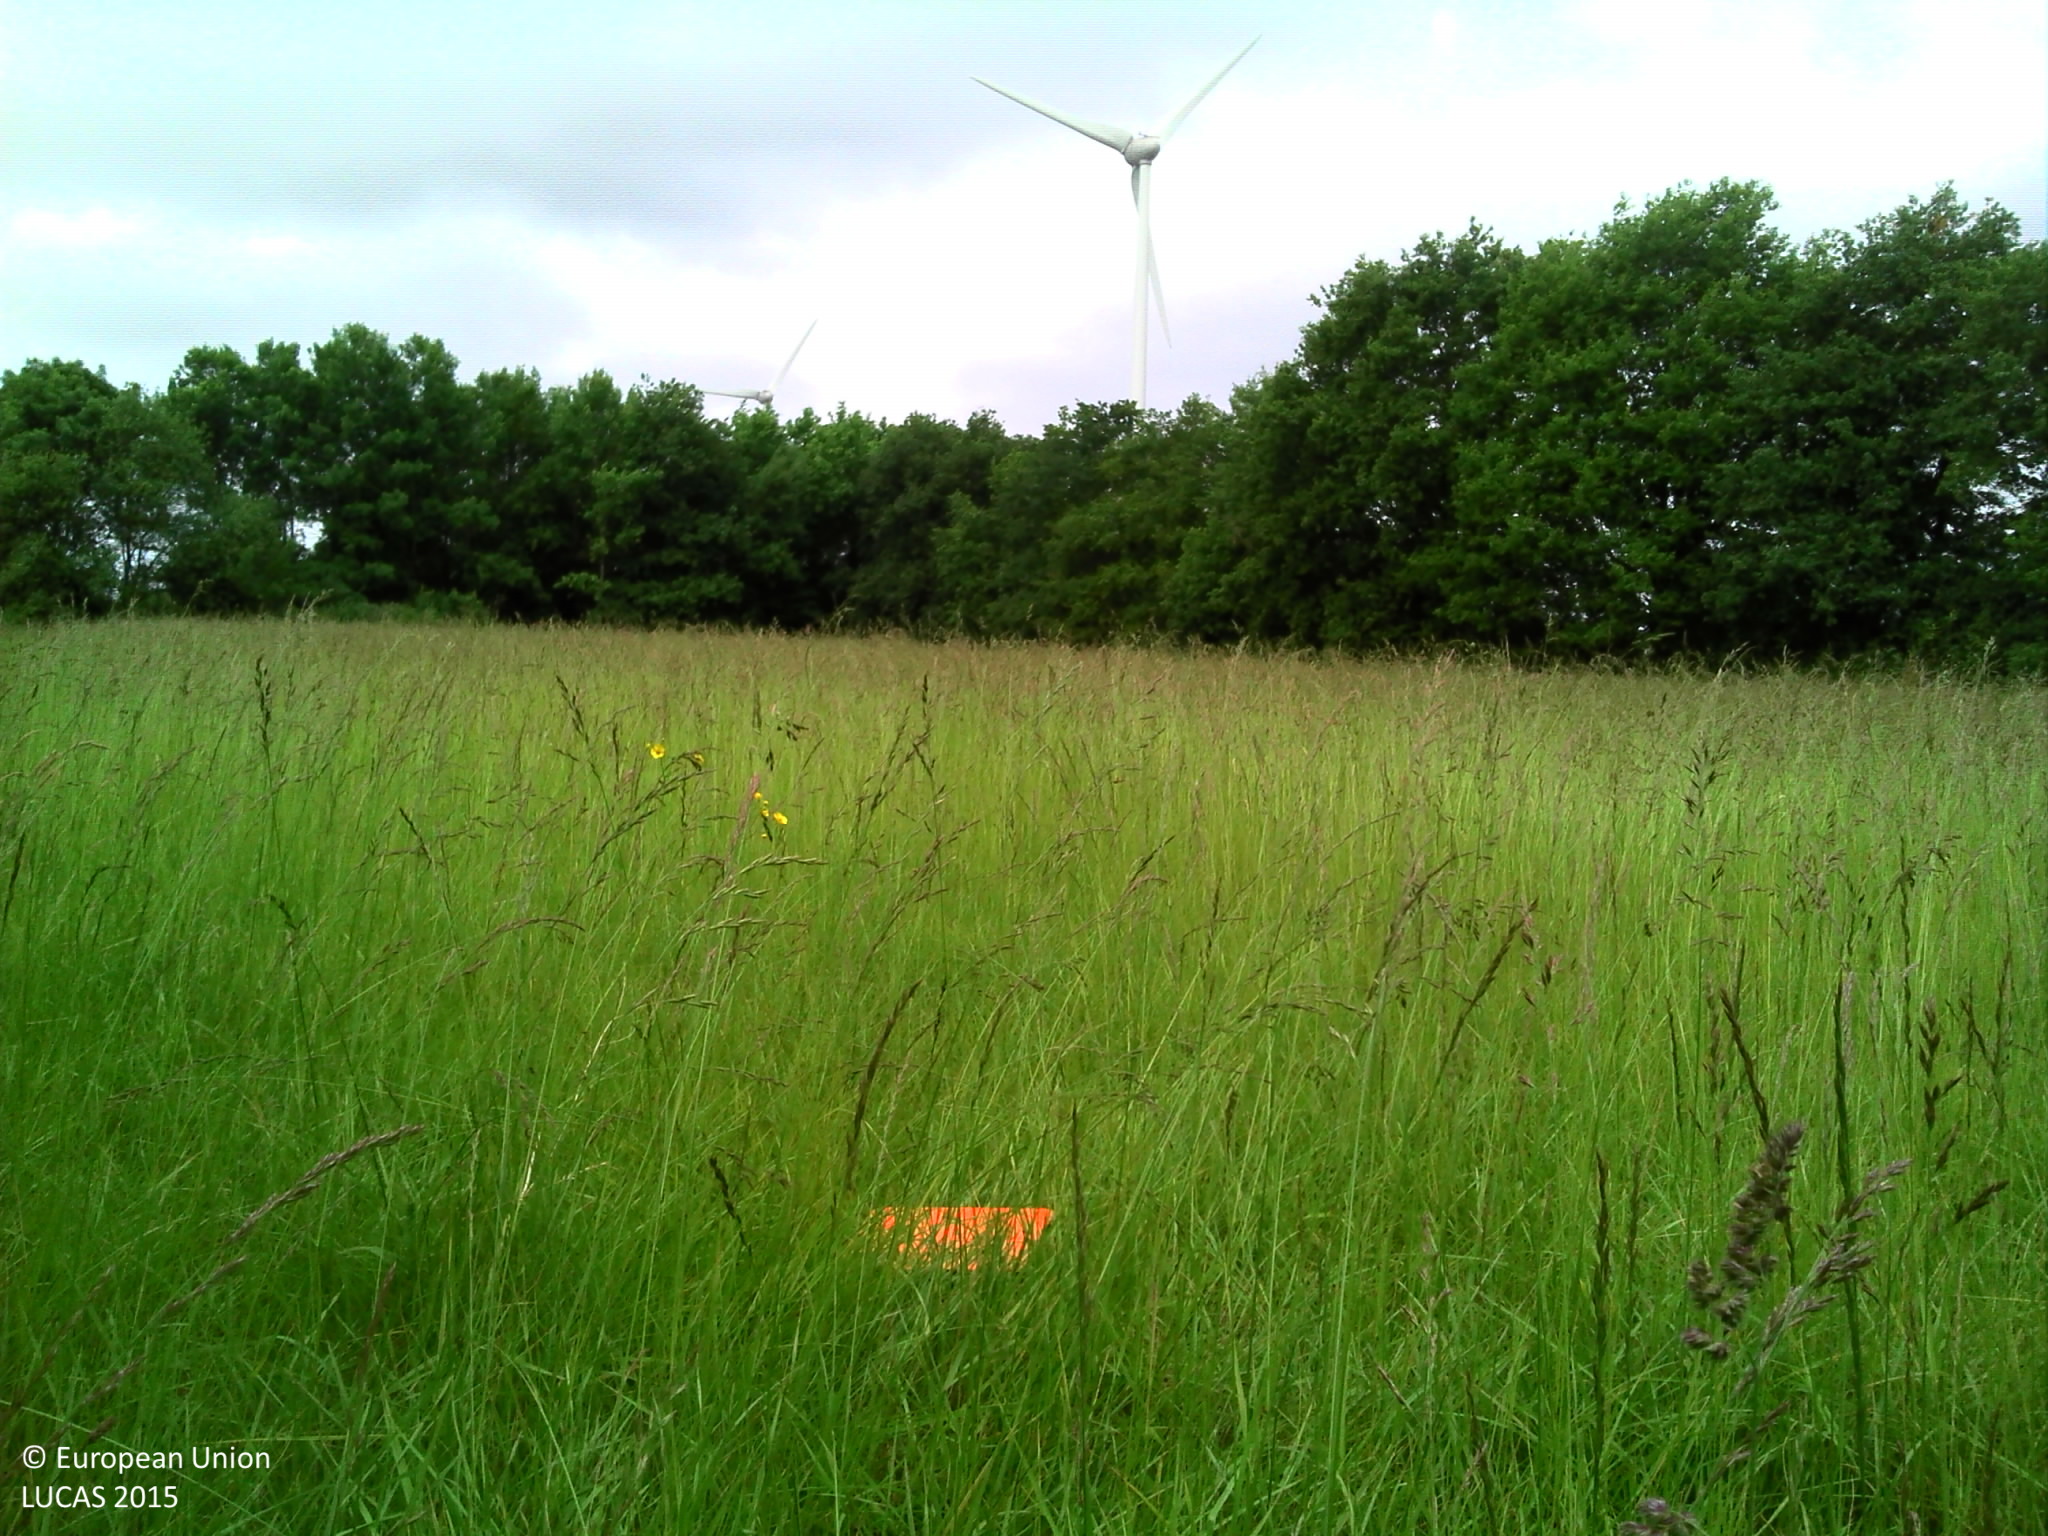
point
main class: Grassland
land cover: Grassland without tree/shrub cover
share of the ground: > 75 %
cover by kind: herbaceous plants 100 %
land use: Agriculture (excluding fallow land and kitchen gardens)
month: June
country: FR
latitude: 47.2277
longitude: -1.2513
